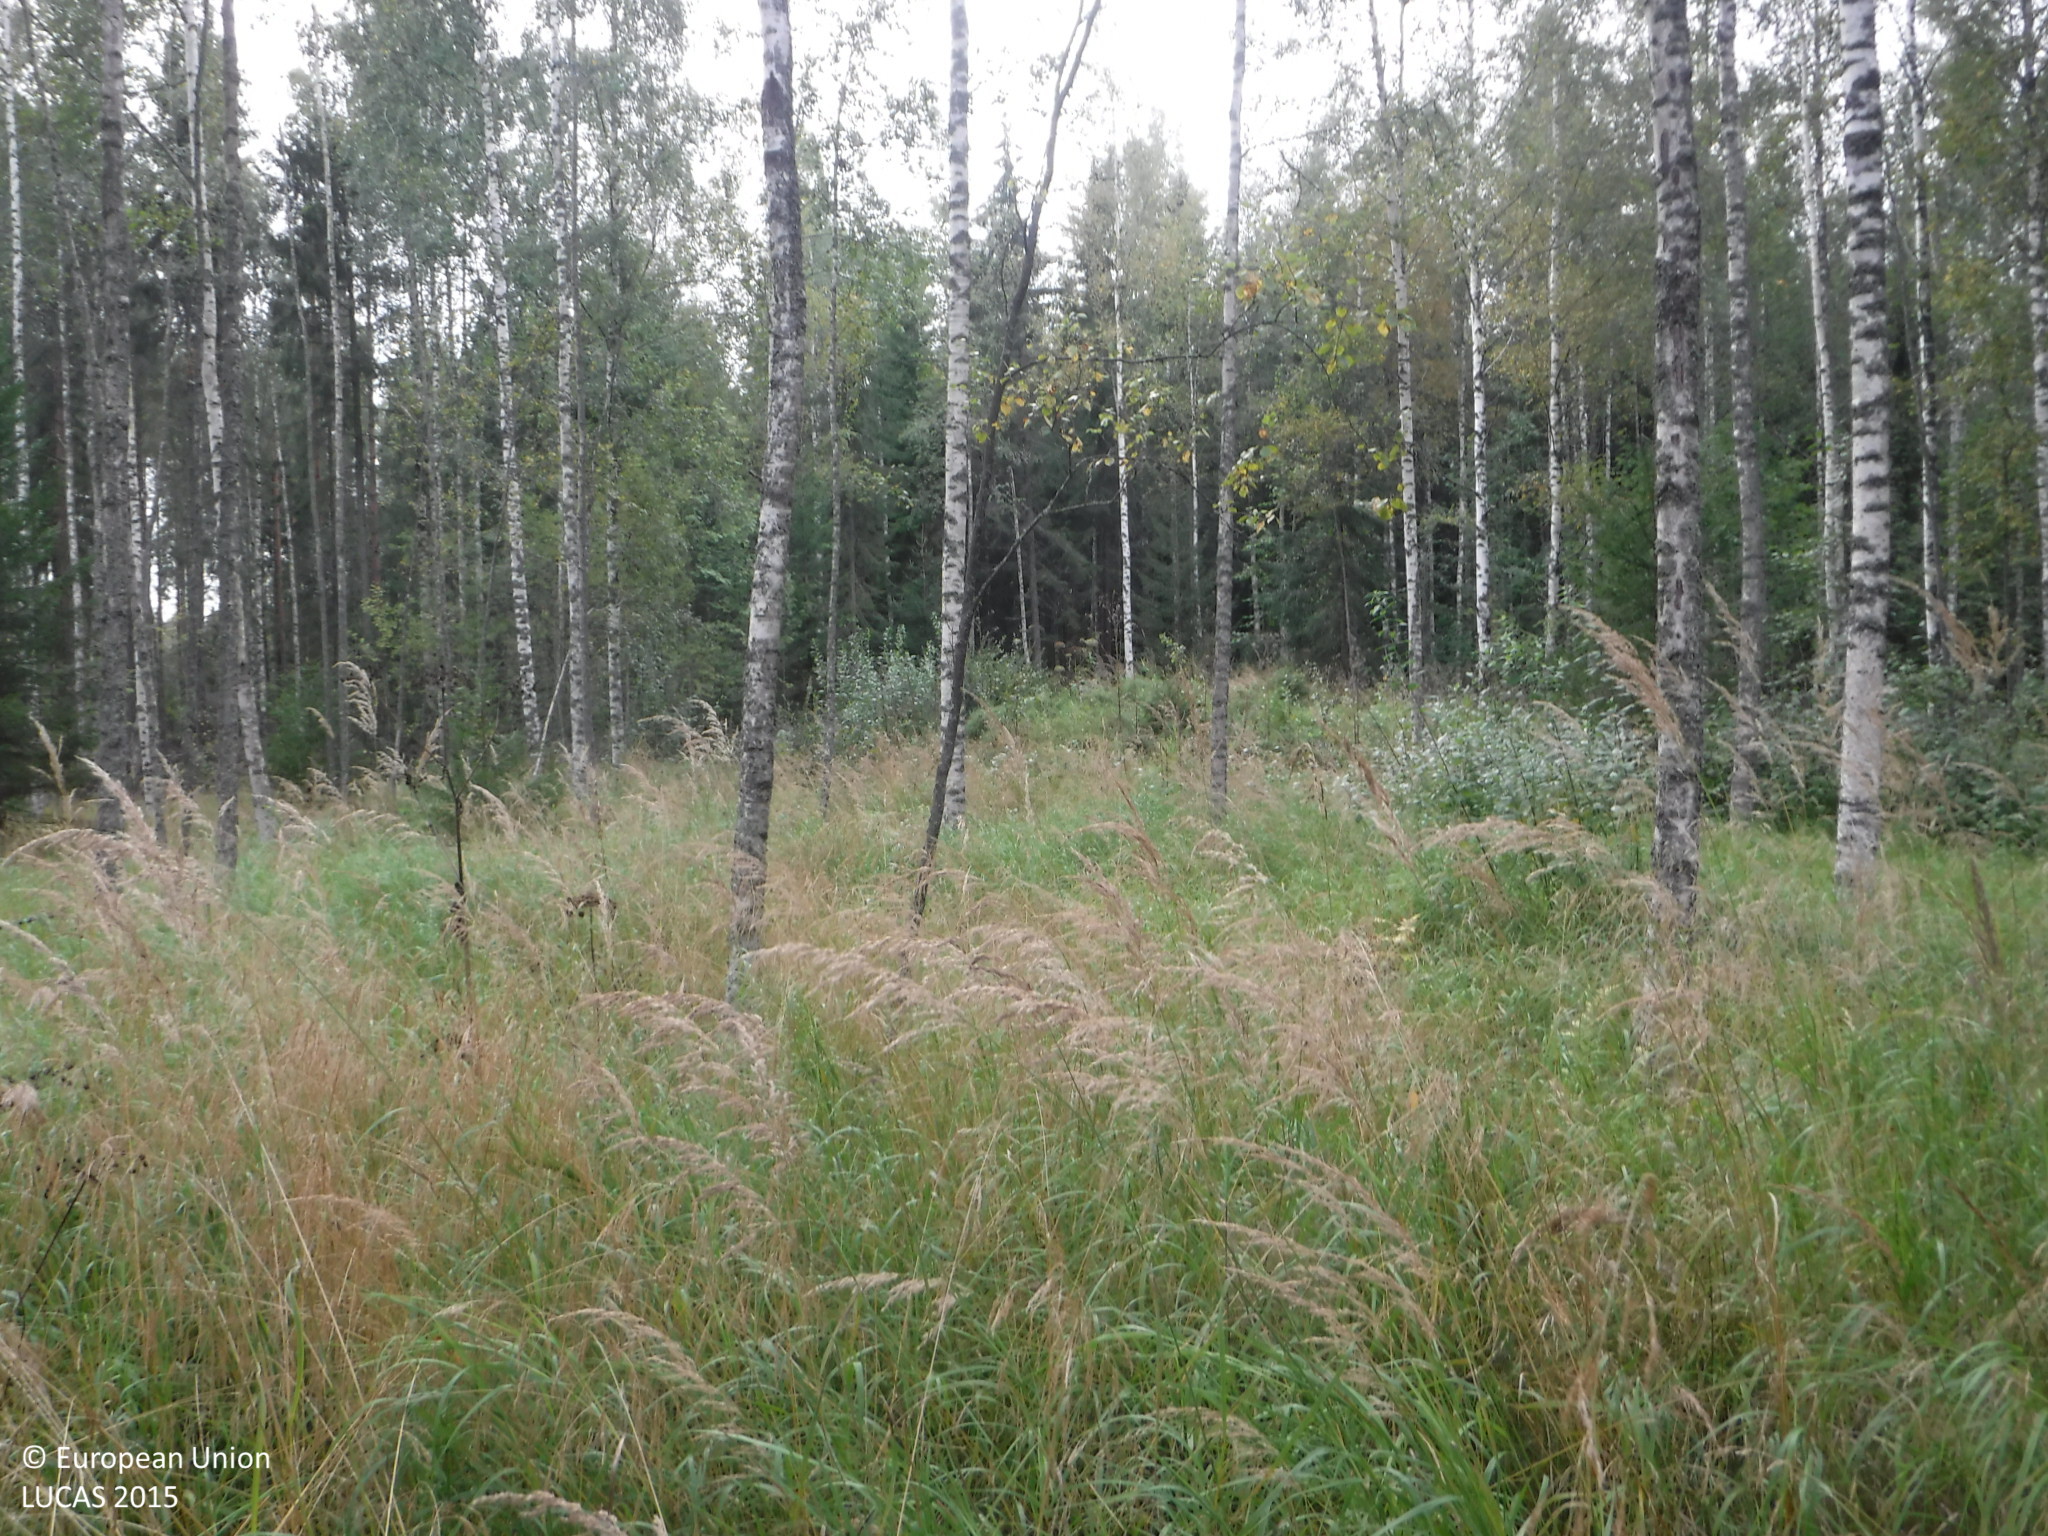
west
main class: Woodland
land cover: Broadleaved woodland
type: non-riverine alder, birch or aspen forest
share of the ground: 25 - 50 %
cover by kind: herbaceous plants 60 %, broadleaved forest trees 35 %, shrubs 5 %
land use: Forestry
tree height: > 5 m
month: September
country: FI
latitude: 61.3479
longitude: 21.9662
